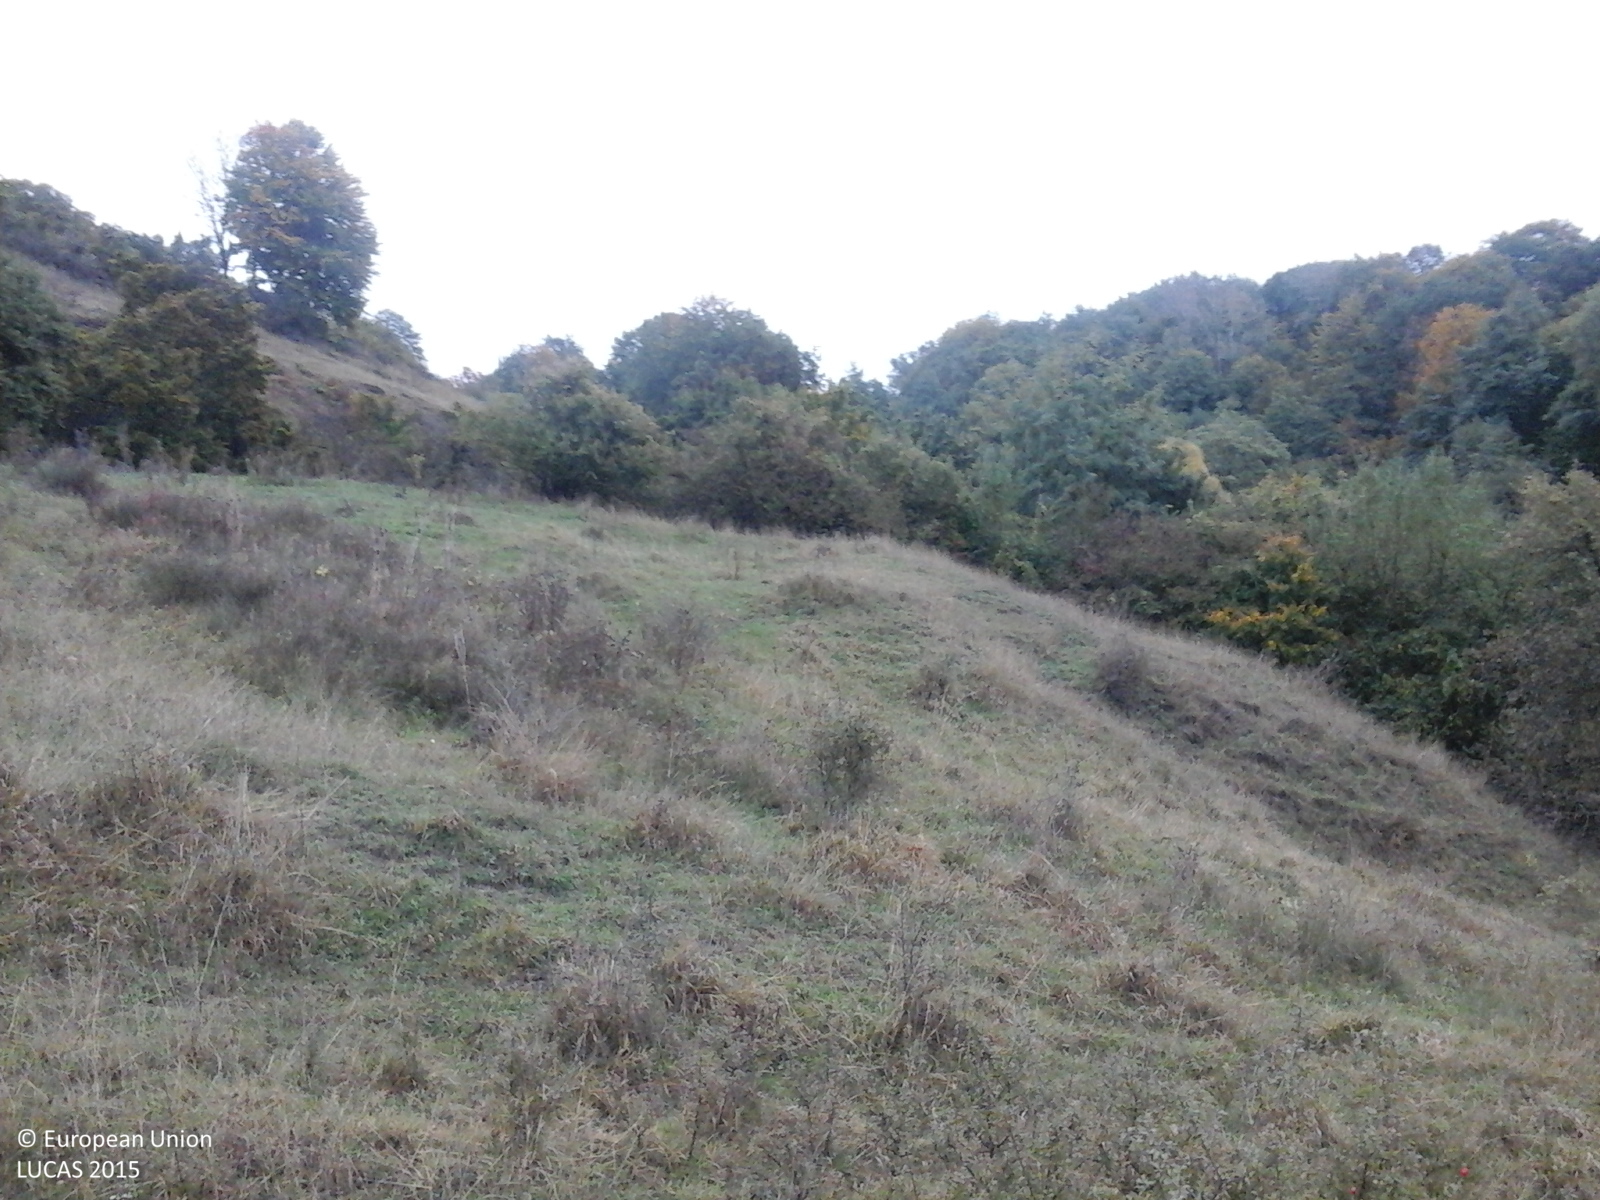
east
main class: Grassland
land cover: Grassland with sparse tree/shrub cover
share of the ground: > 75 %
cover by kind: herbaceous plants 85 %, shrubs 10 %, broadleaved forest trees 5 %
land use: Agriculture (excluding fallow land and kitchen gardens)
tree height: < 5 m
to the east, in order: Grassland with sparse tree/shrub cover; Broadleaved woodland; Grassland with sparse tree/shrub cover
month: October
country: RO
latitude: 46.0518
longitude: 24.2306
